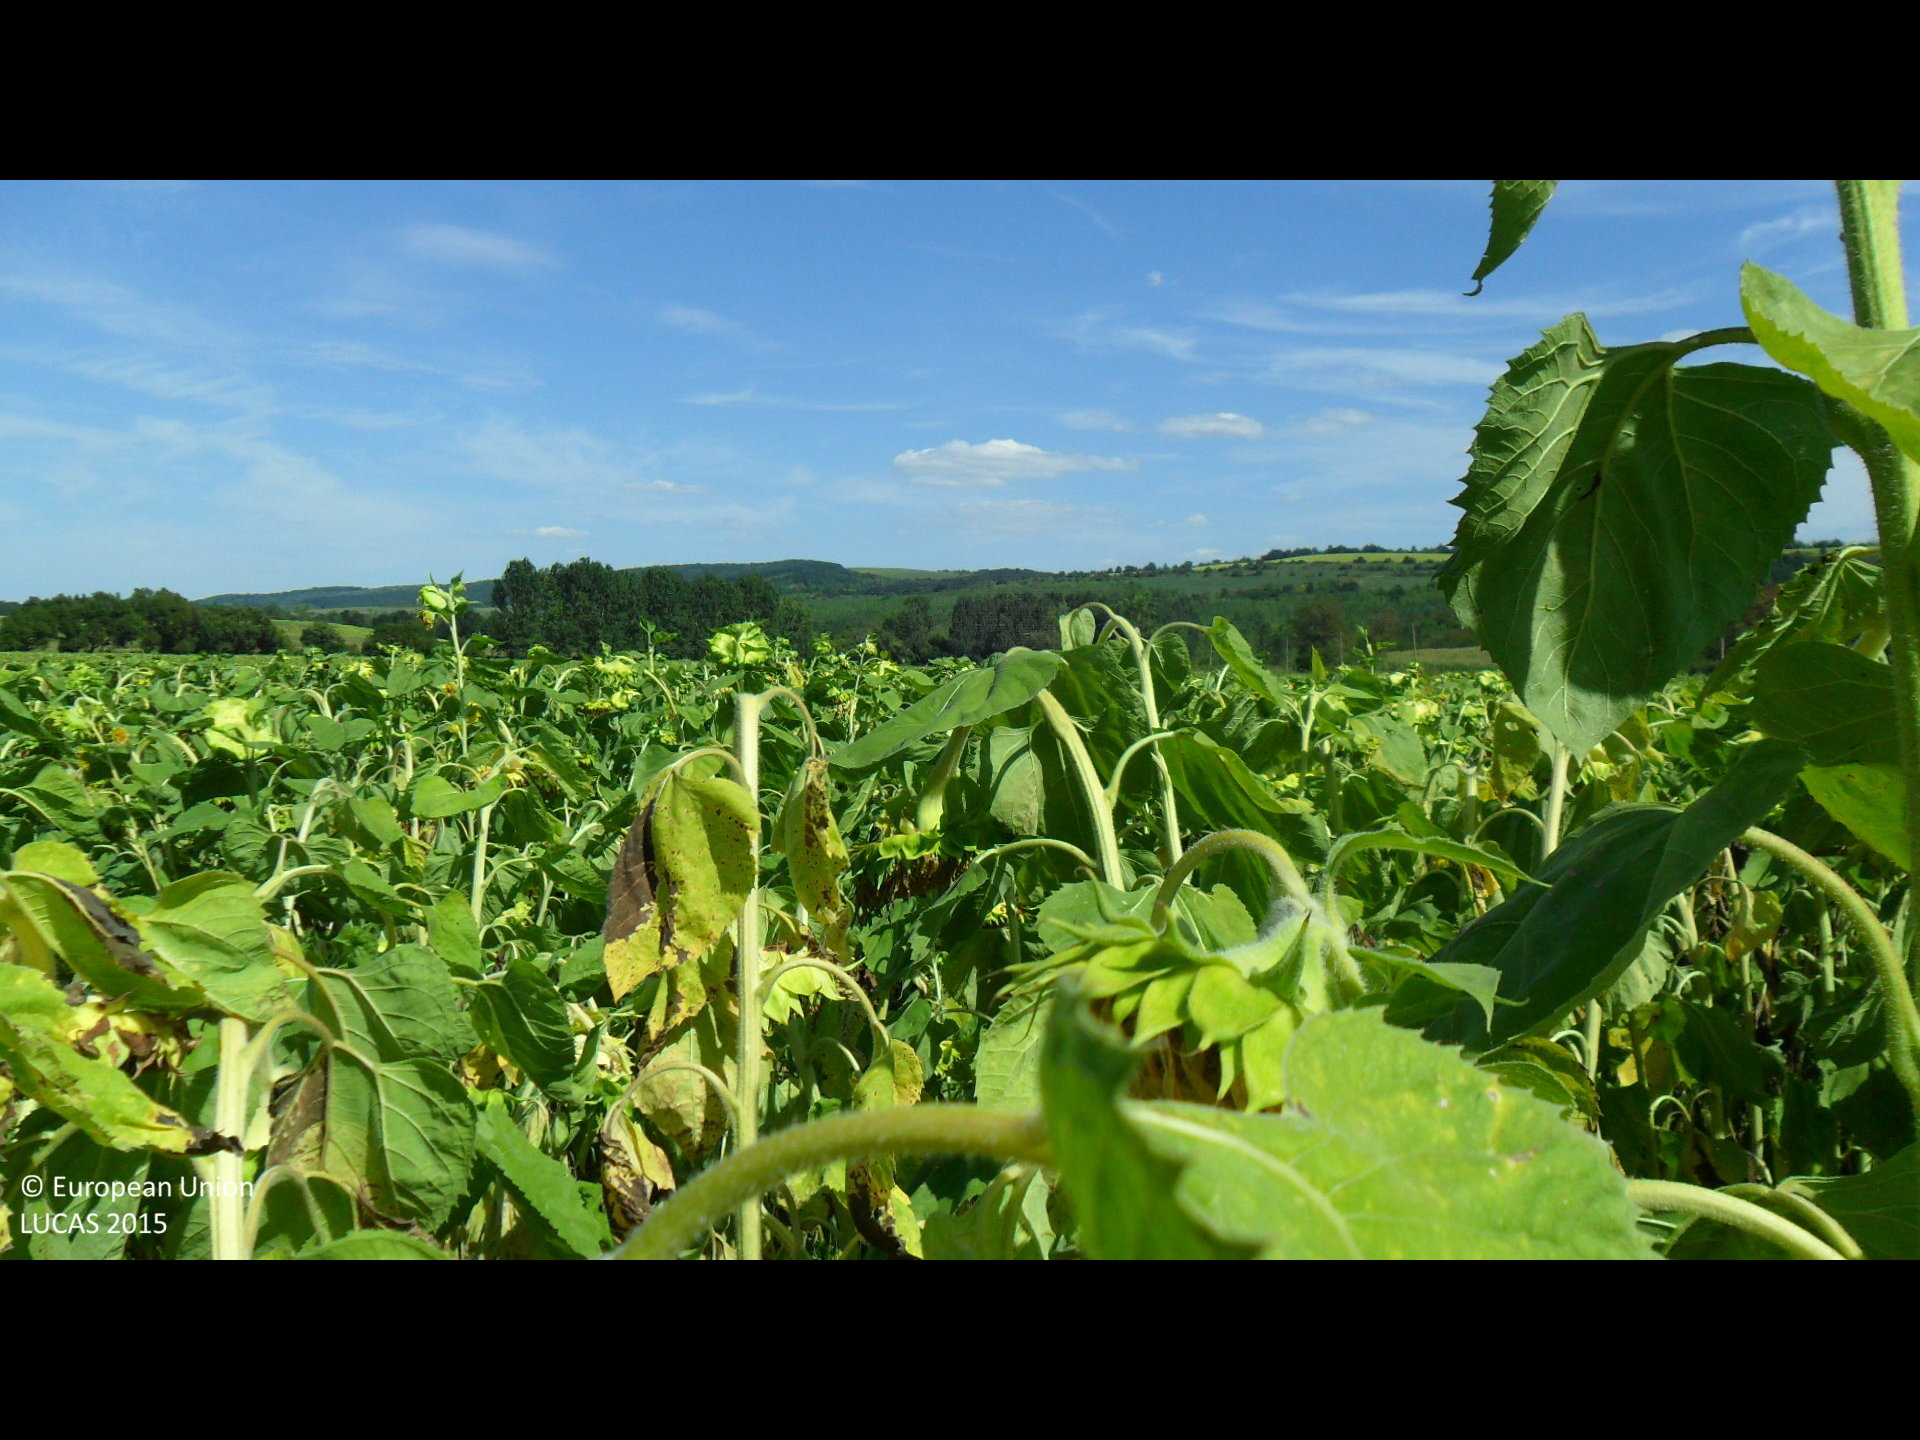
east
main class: Cropland
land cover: Sunflower
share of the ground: > 75 %
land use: Agriculture (excluding fallow land and kitchen gardens)
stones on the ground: < 10 %
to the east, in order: Sunflower
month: August
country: BG
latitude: 43.3206
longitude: 26.3386
